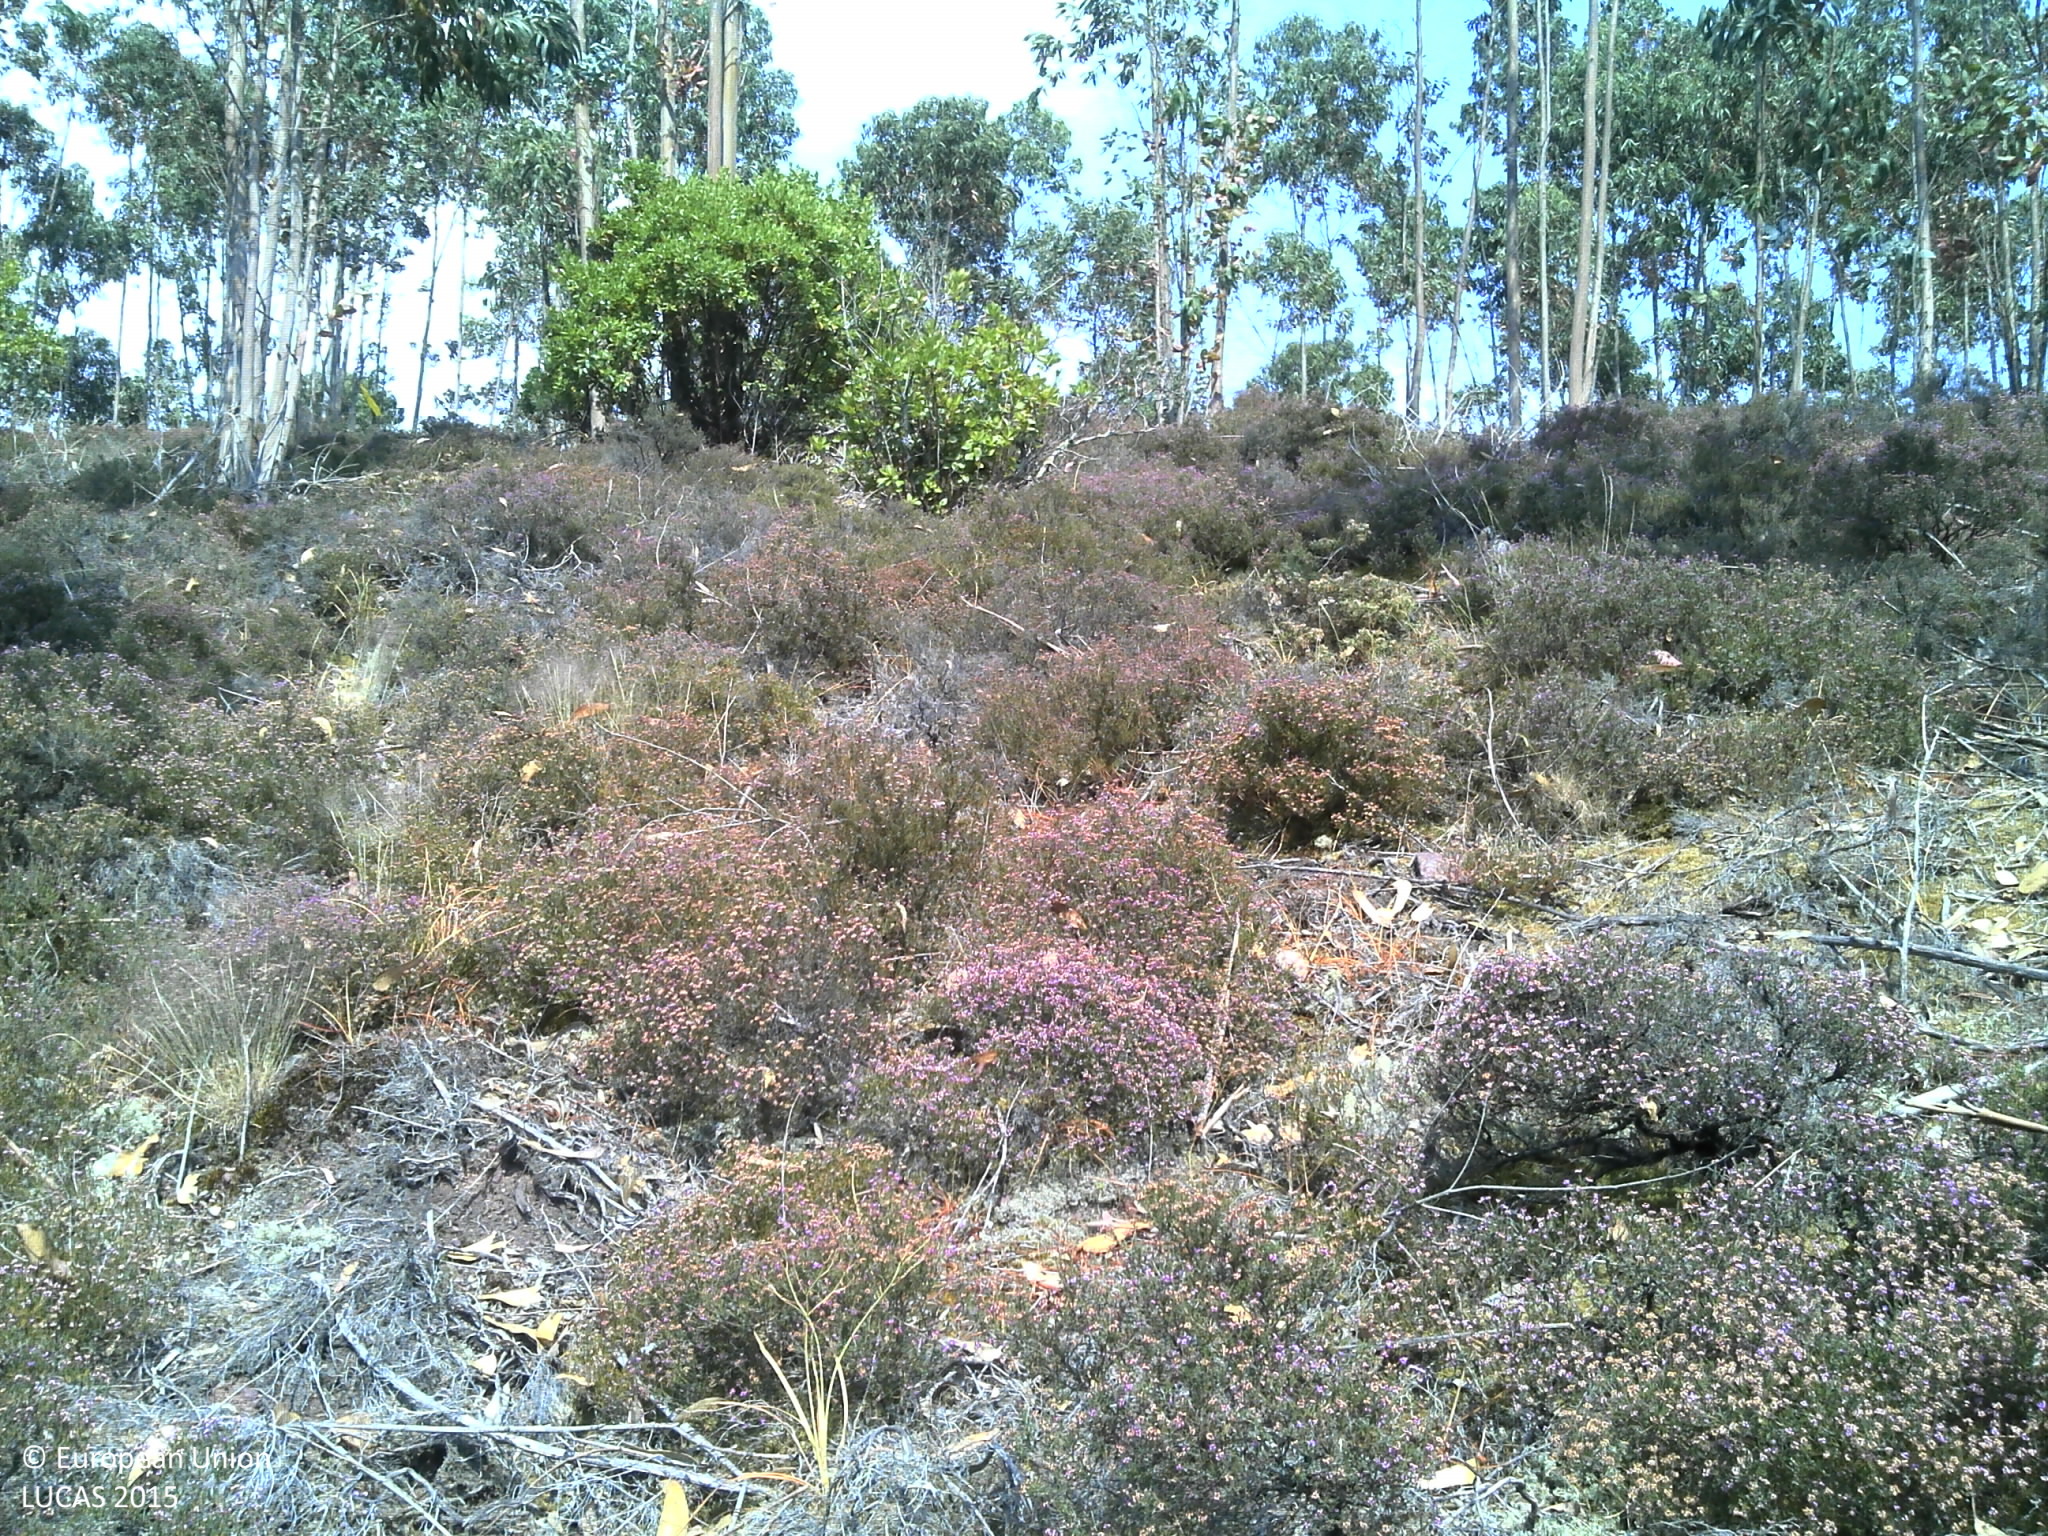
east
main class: Woodland
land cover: Broadleaved woodland
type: exotic forest
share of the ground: 50 - 75 %
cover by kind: broadleaved forest trees 55 %, shrubs 30 %, unconsolidated bare surface 15 %
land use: Forestry
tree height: > 5 m
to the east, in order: Broadleaved woodland; Shrubland with sparse tree cover; Broadleaved woodland; Tracks; Broadleaved woodland; Permanent crops (only in case pi); Tracks; Broadleaved woodland; Tracks; Broadleaved woodland; Tracks; Broadleaved woodland; Permanent crops (only in case pi)
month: June
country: PT
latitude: 40.3865
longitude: -8.3553
